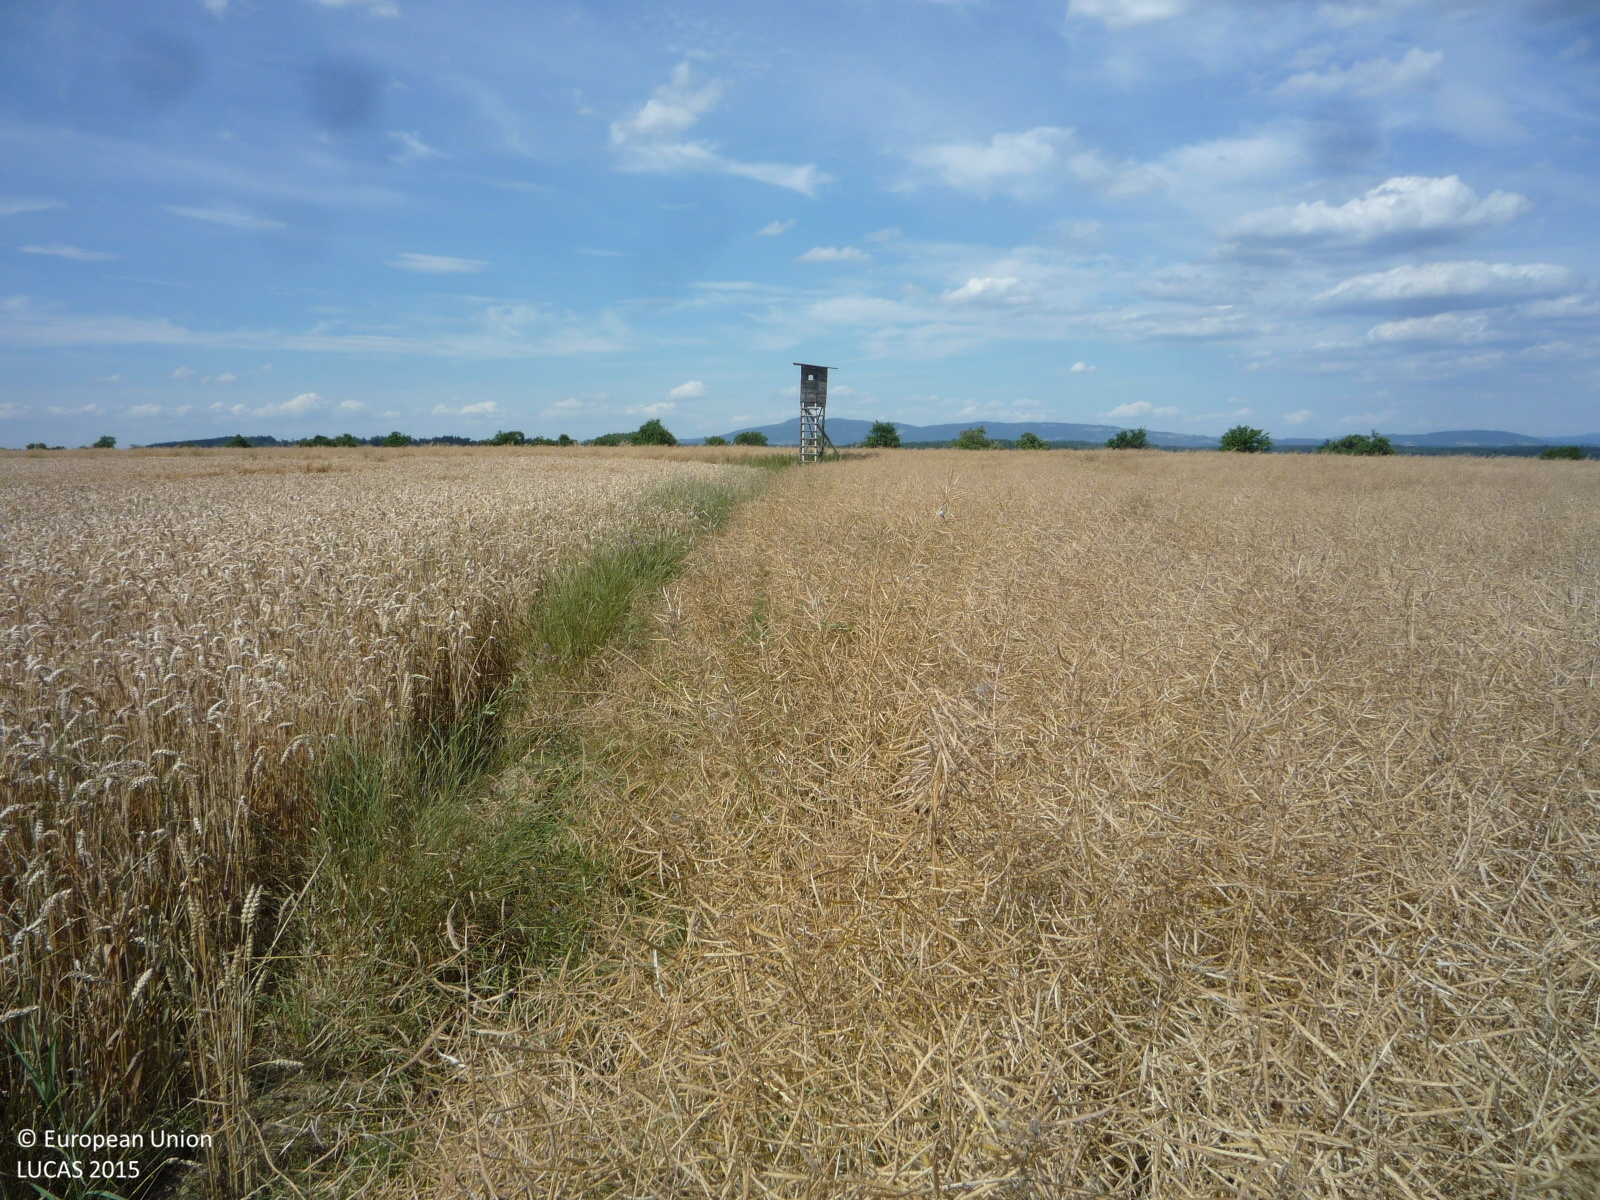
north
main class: Cropland
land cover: Rape and turnip rape
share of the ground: > 75 %
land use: Agriculture (excluding fallow land and kitchen gardens)
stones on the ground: < 10 %
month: July
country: CZ
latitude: 50.5629
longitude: 14.9579
